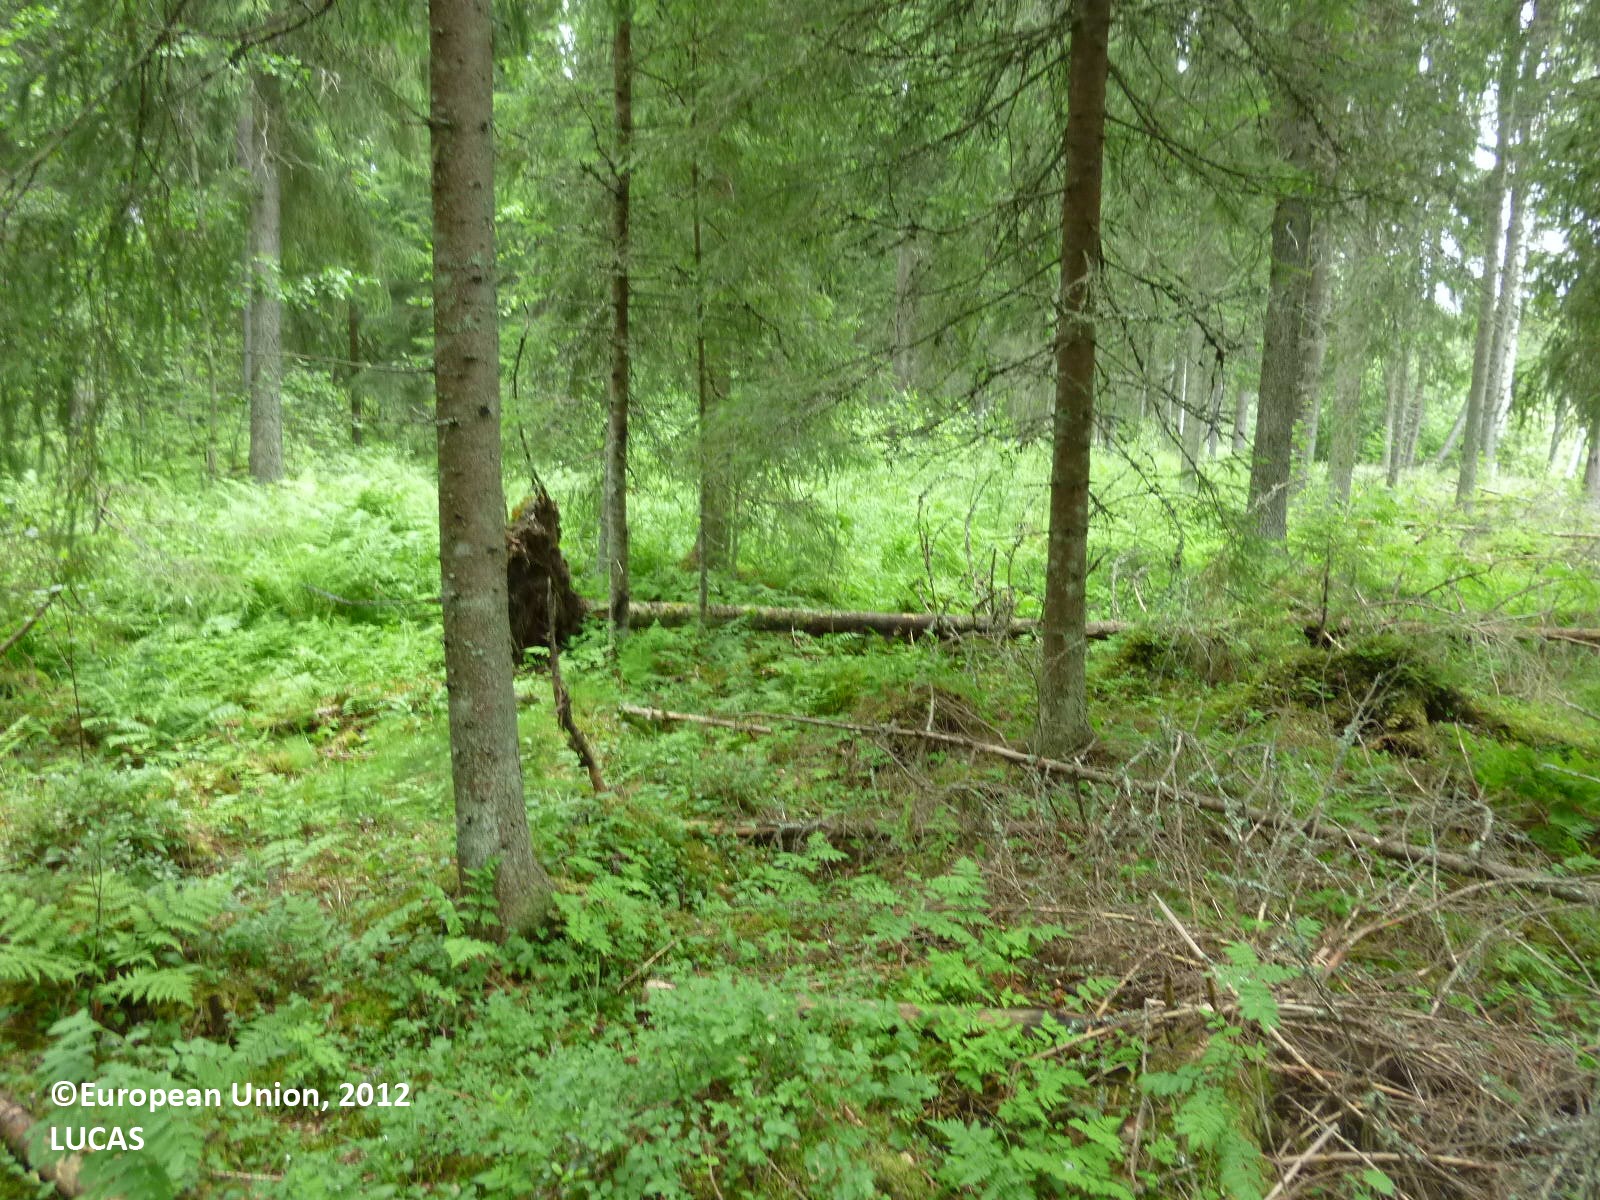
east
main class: Woodland
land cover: Spruce dominated coniferous woodland
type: boreal forest
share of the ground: > 75 %
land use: Forestry
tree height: > 5 m
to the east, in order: Spruce dominated coniferous woodland; Ditches and canals; Spruce dominated coniferous woodland; Rivers and streams; Spruce dominated coniferous woodland; Rivers and streams; Spruce dominated coniferous woodland; Rivers and streams; Spruce dominated coniferous woodland
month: July
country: FI
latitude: 61.7020
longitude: 22.1017
